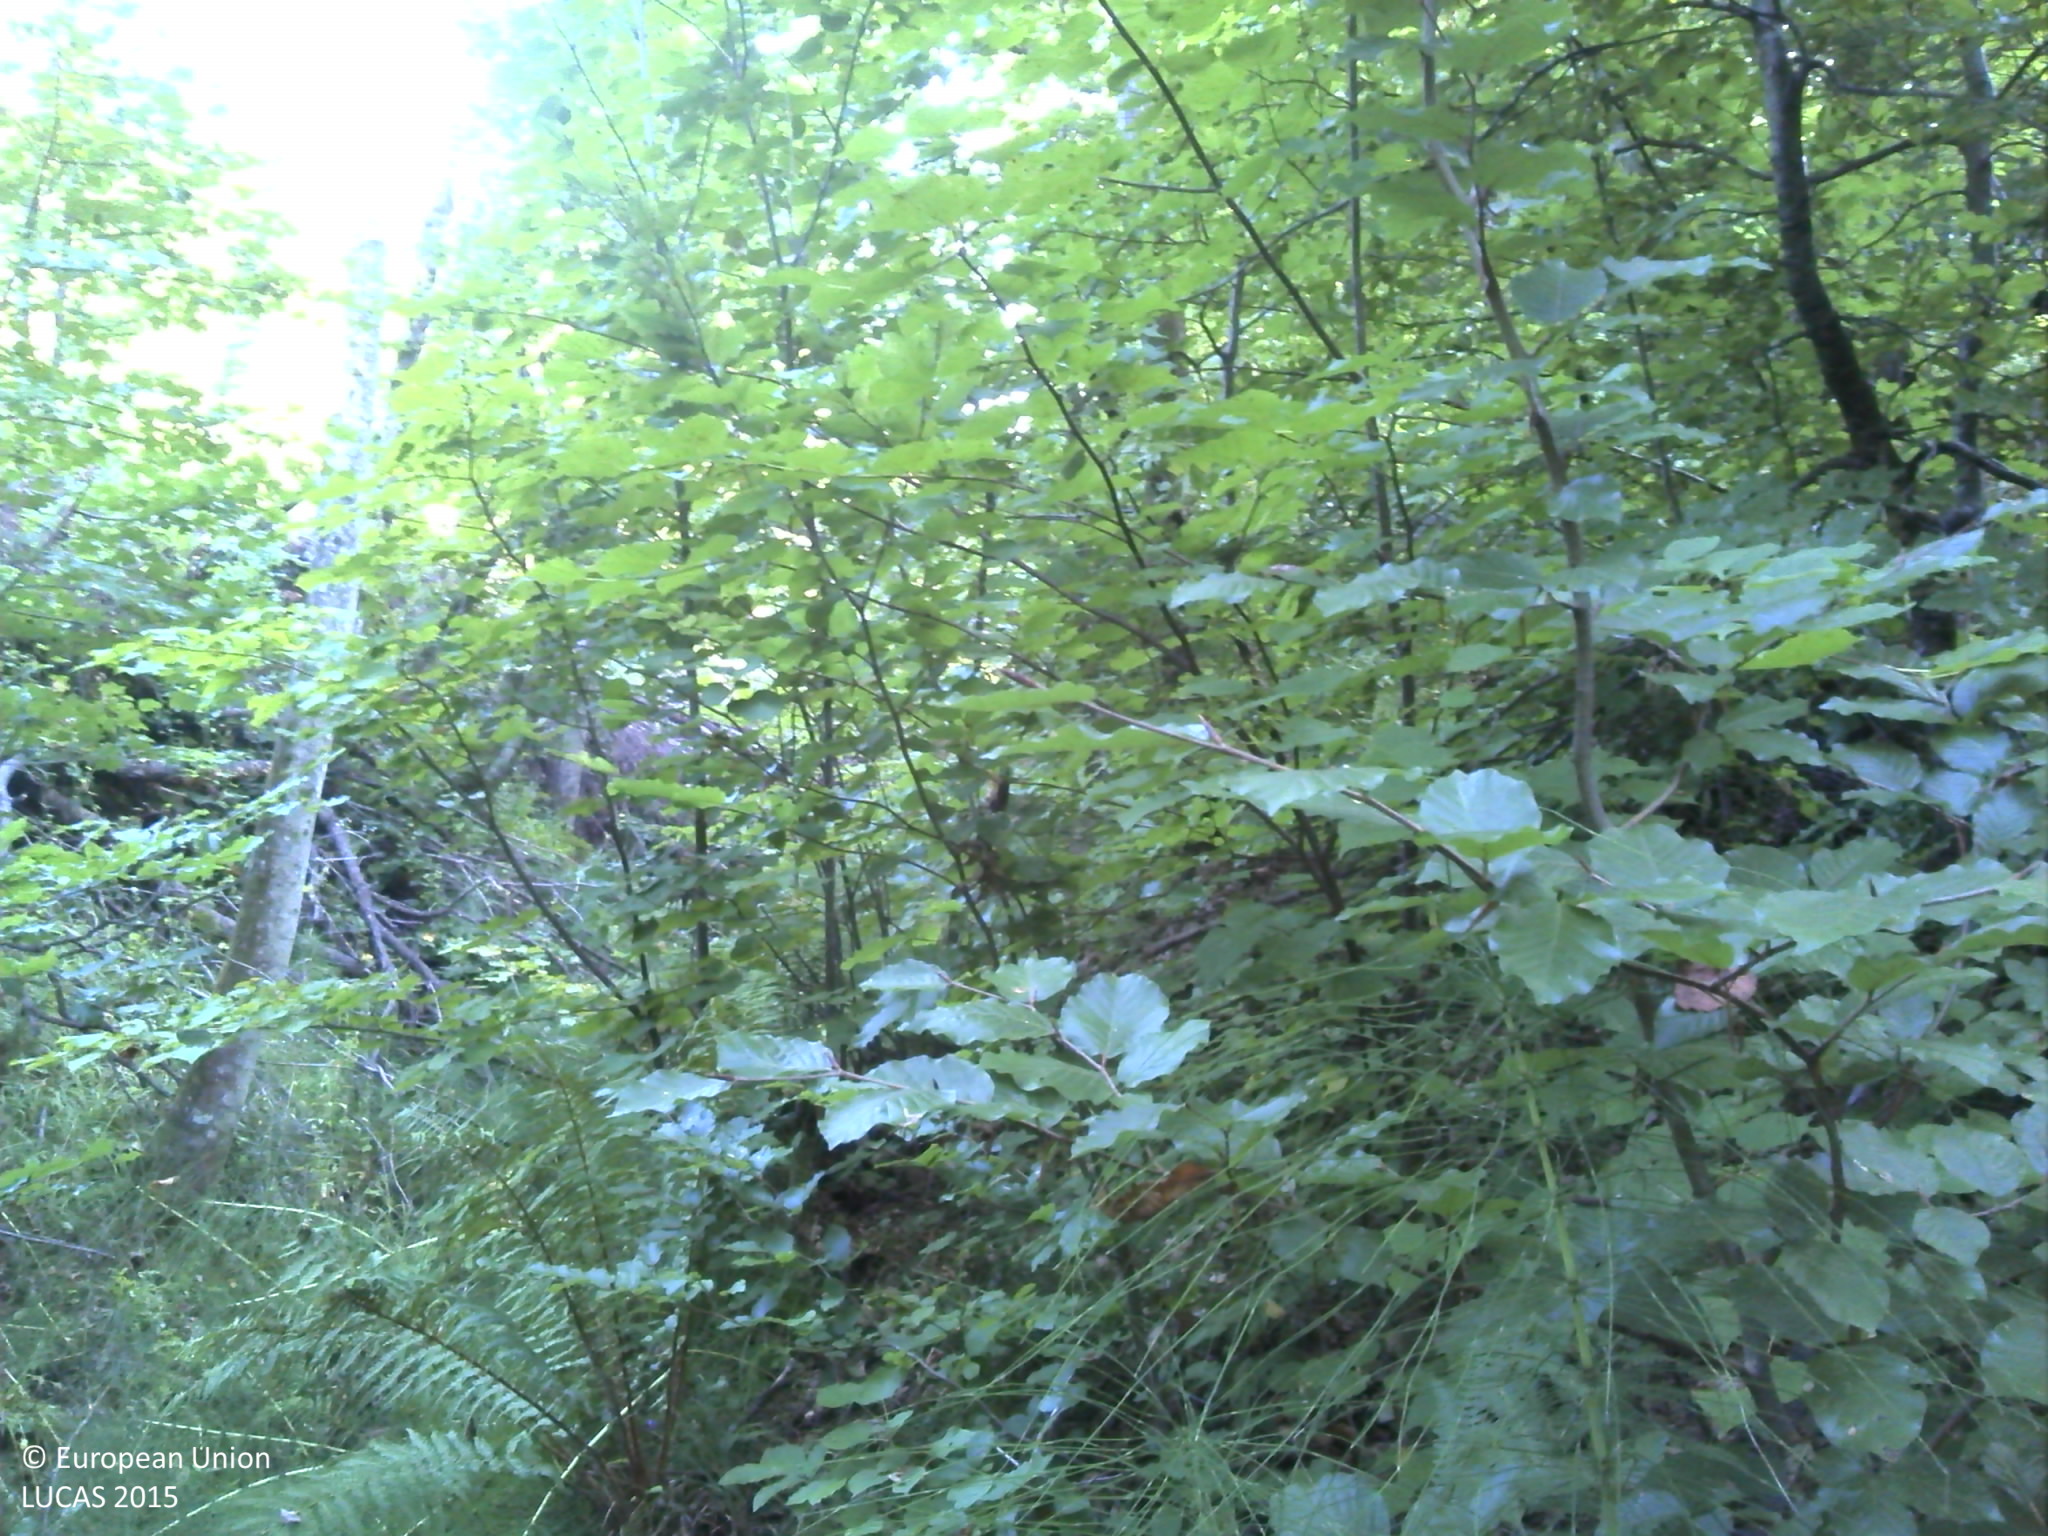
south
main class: Woodland
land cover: Broadleaved woodland
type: beech forest
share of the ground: > 75 %
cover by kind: broadleaved forest trees 100 %
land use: Forestry
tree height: > 5 m
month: August
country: HR
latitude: 45.3031
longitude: 16.5145
